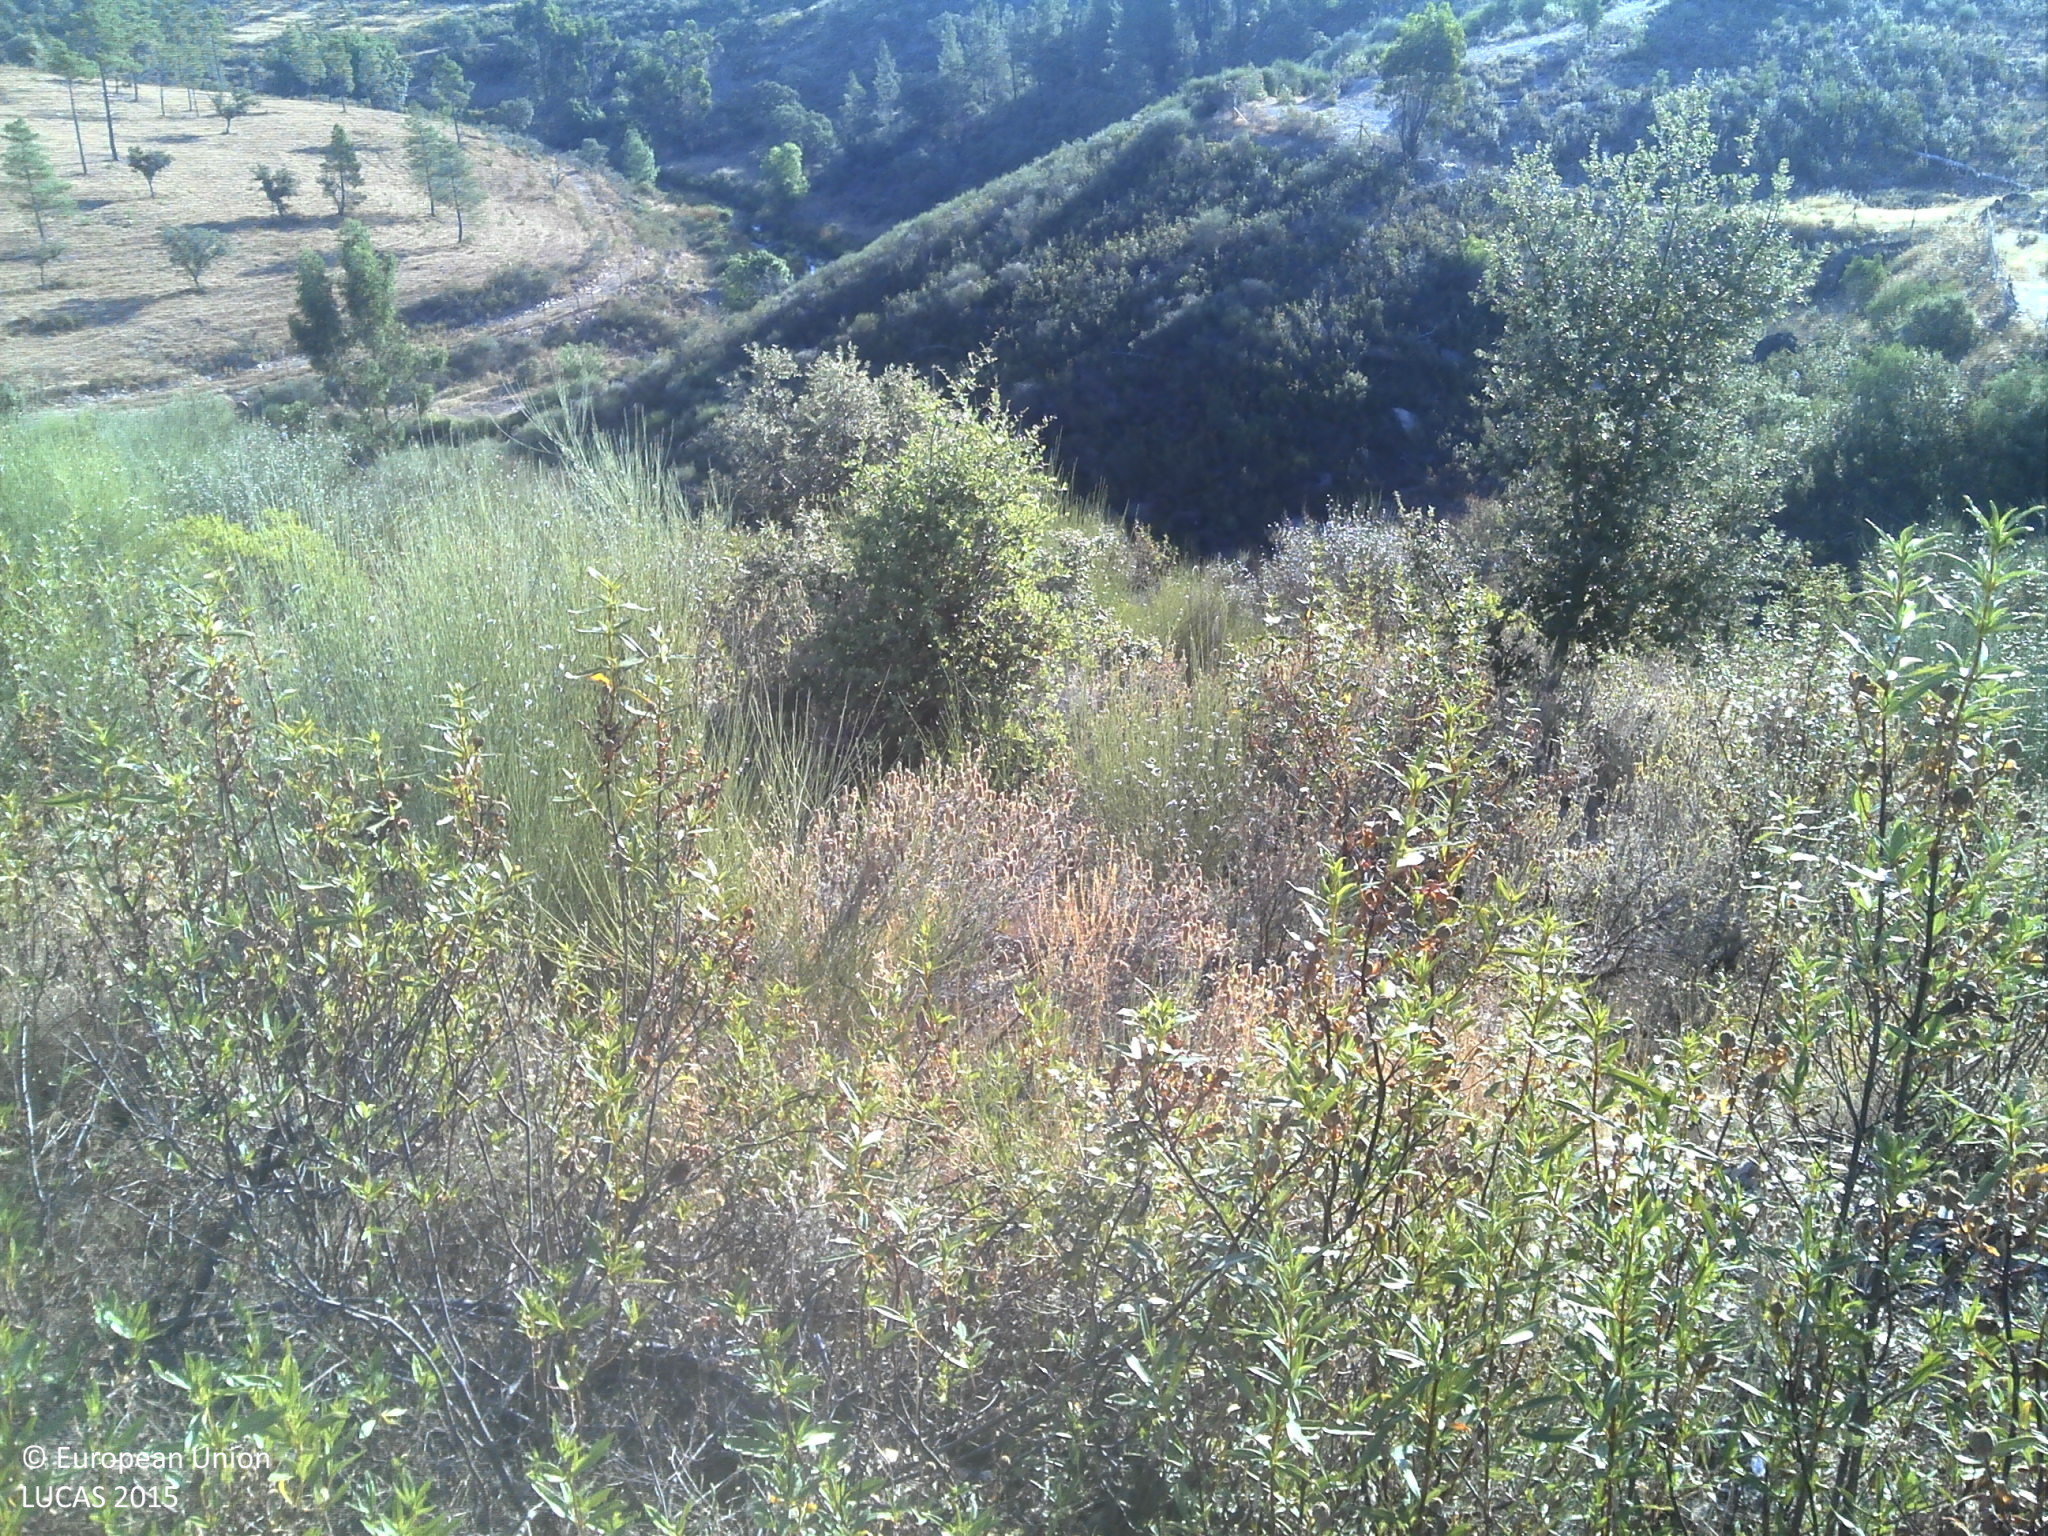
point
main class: Shrubland
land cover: Shrubland without tree cover
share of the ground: 50 - 75 %
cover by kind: shrubs 65 %, unconsolidated bare surface 15 %, herbaceous plants 10 %
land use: Semi-natural and natural areas not in use
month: July
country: PT
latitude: 39.8309
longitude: -7.5694
